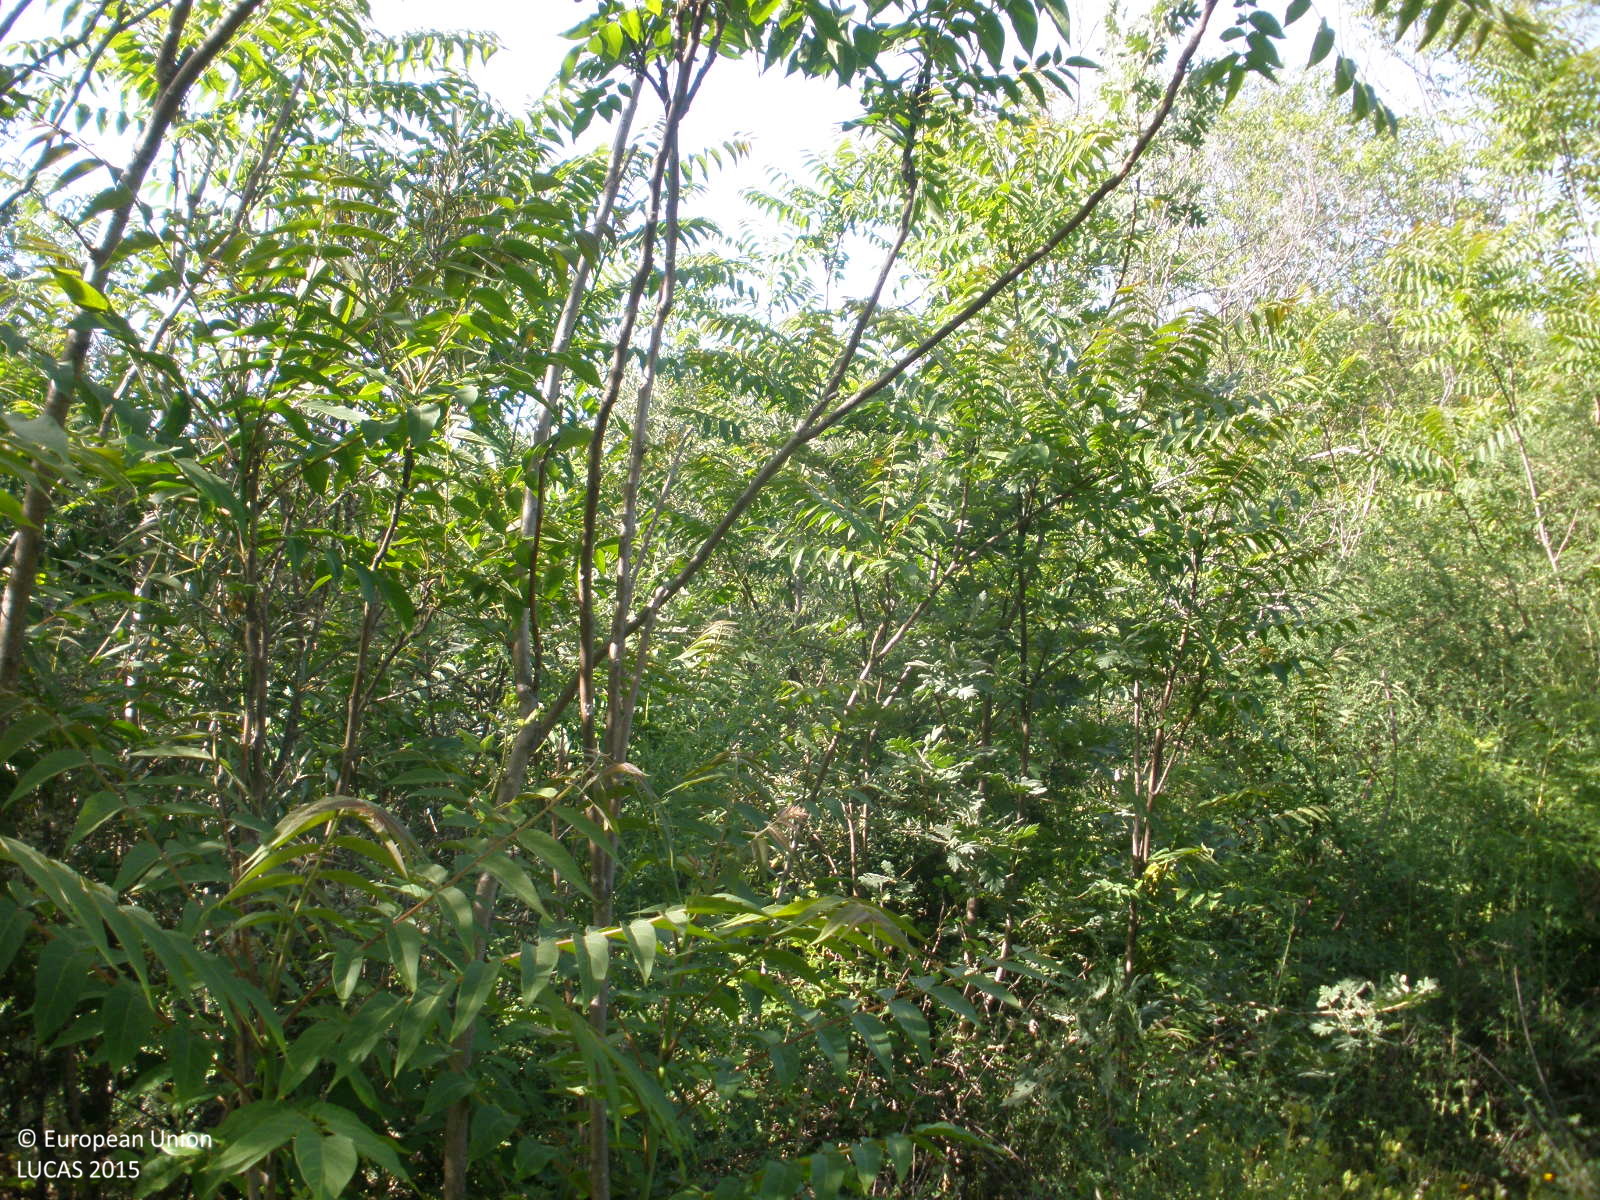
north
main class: Woodland
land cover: Broadleaved woodland
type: thermophilous deciduous forest
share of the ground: > 75 %
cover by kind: broadleaved forest trees 70 %, shrubs 30 %
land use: Semi-natural and natural areas not in use
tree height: > 5 m
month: May
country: ES
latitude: 40.1988
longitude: -6.6378
